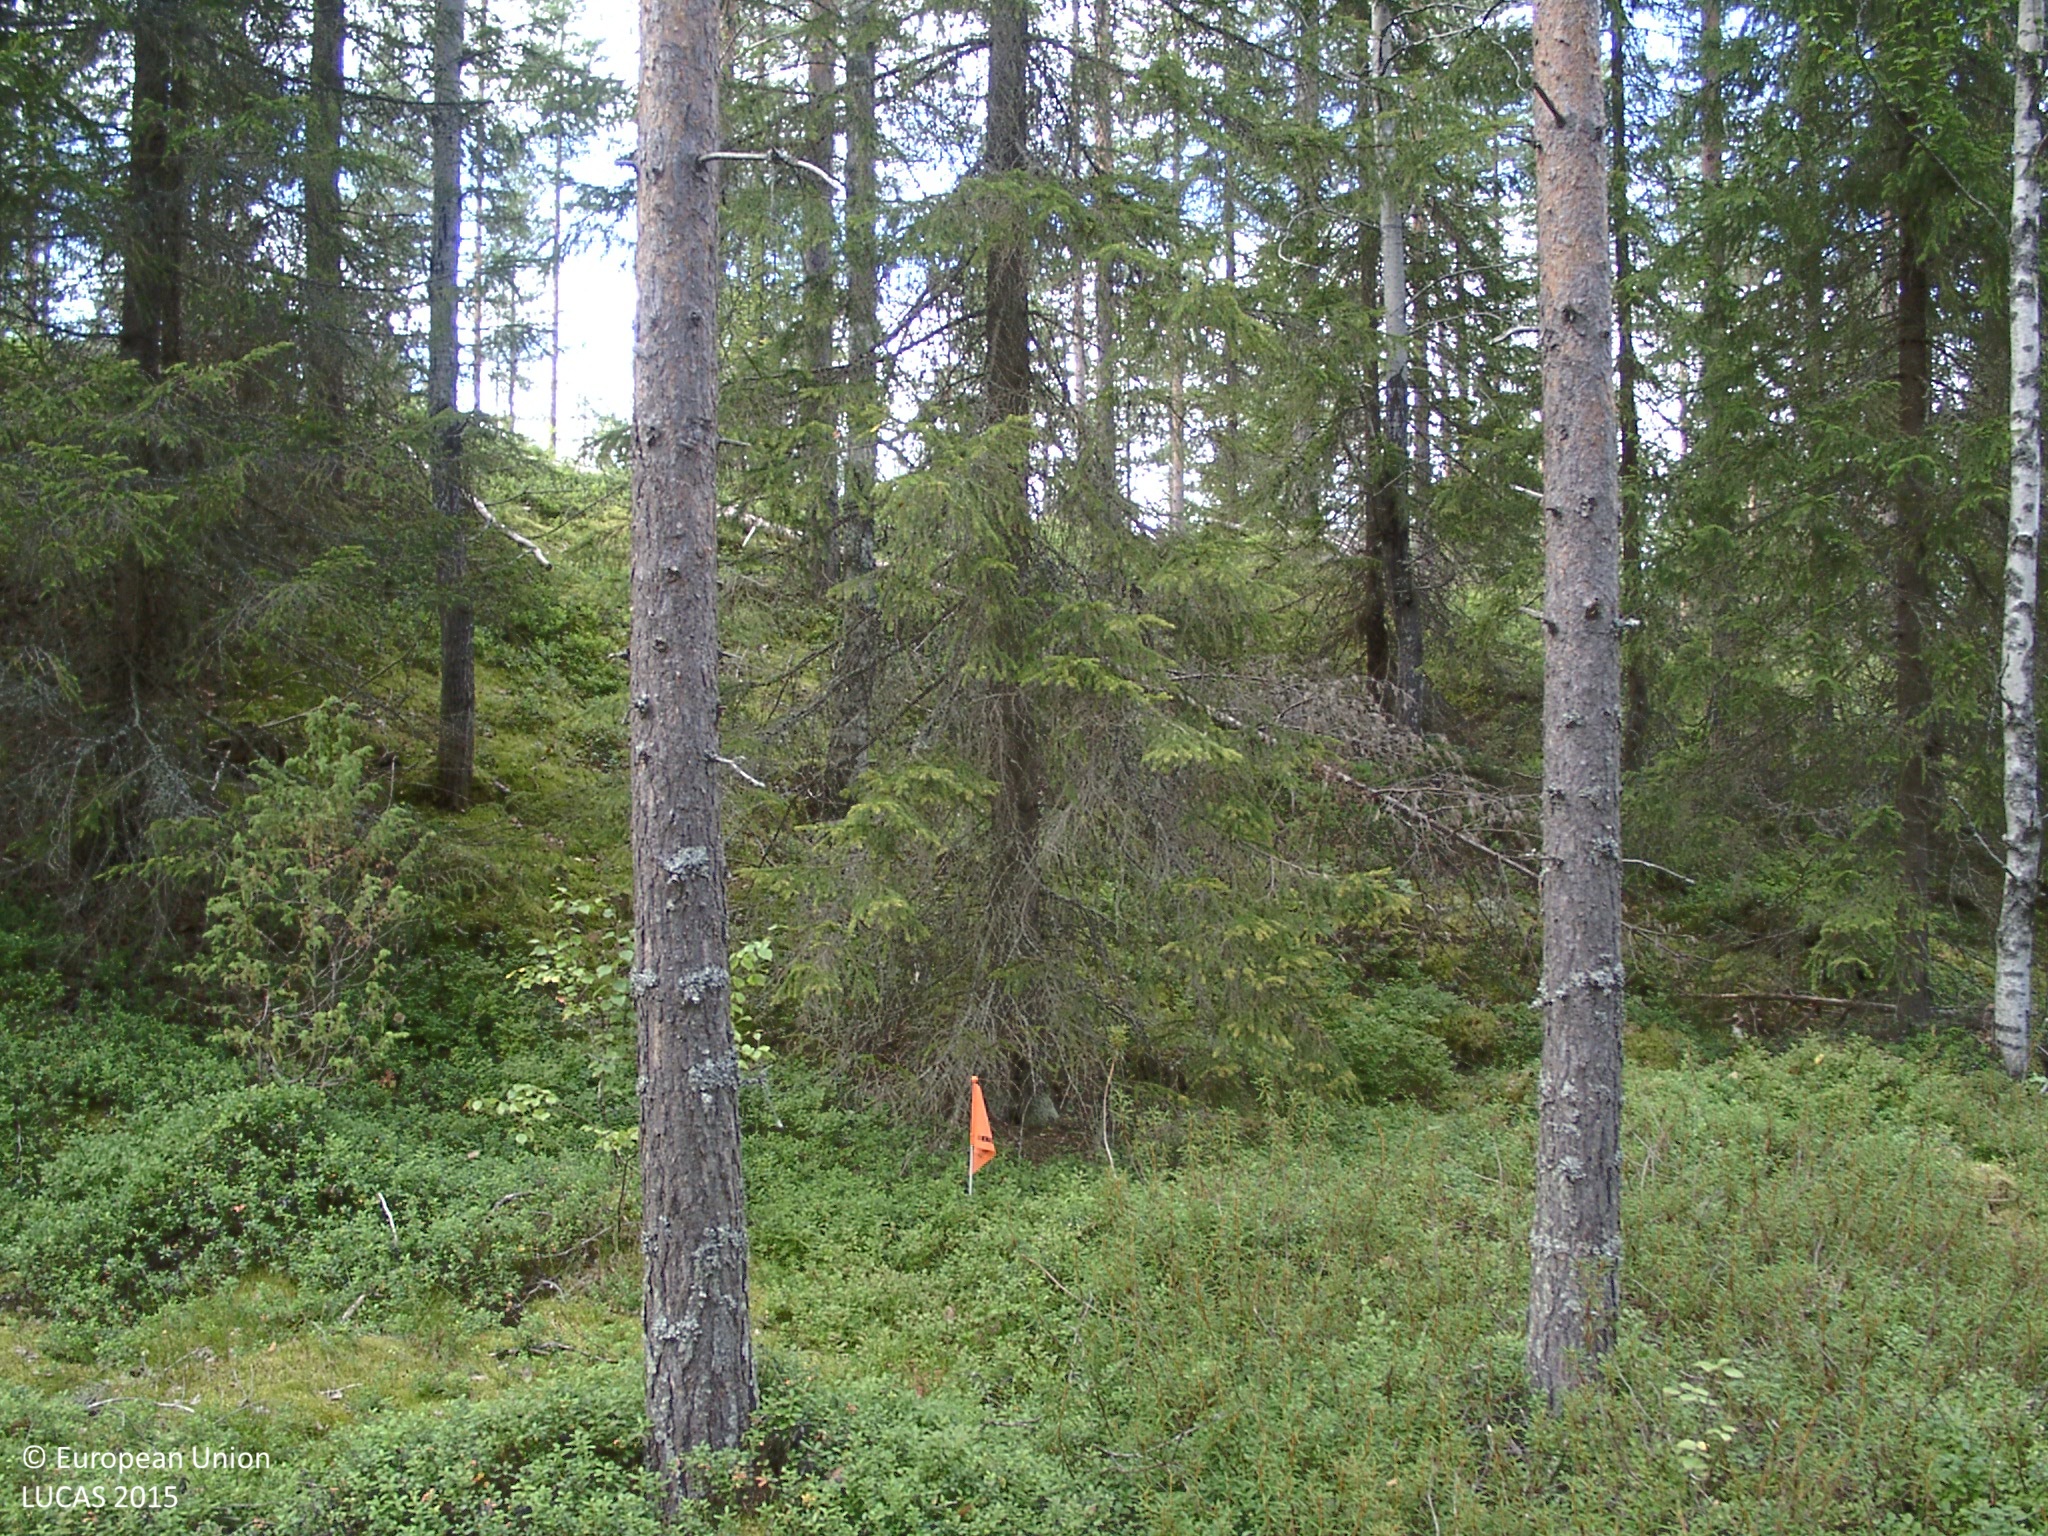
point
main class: Woodland
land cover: Other mixed woodland
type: boreal forest
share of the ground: 50 - 75 %
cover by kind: coniferous forest trees 50 %, broadleaved forest trees 20 %, shrubs 20 %, lichens and mosses 10 %
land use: Forestry
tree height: > 5 m
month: August
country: FI
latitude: 62.3935
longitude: 25.4908
